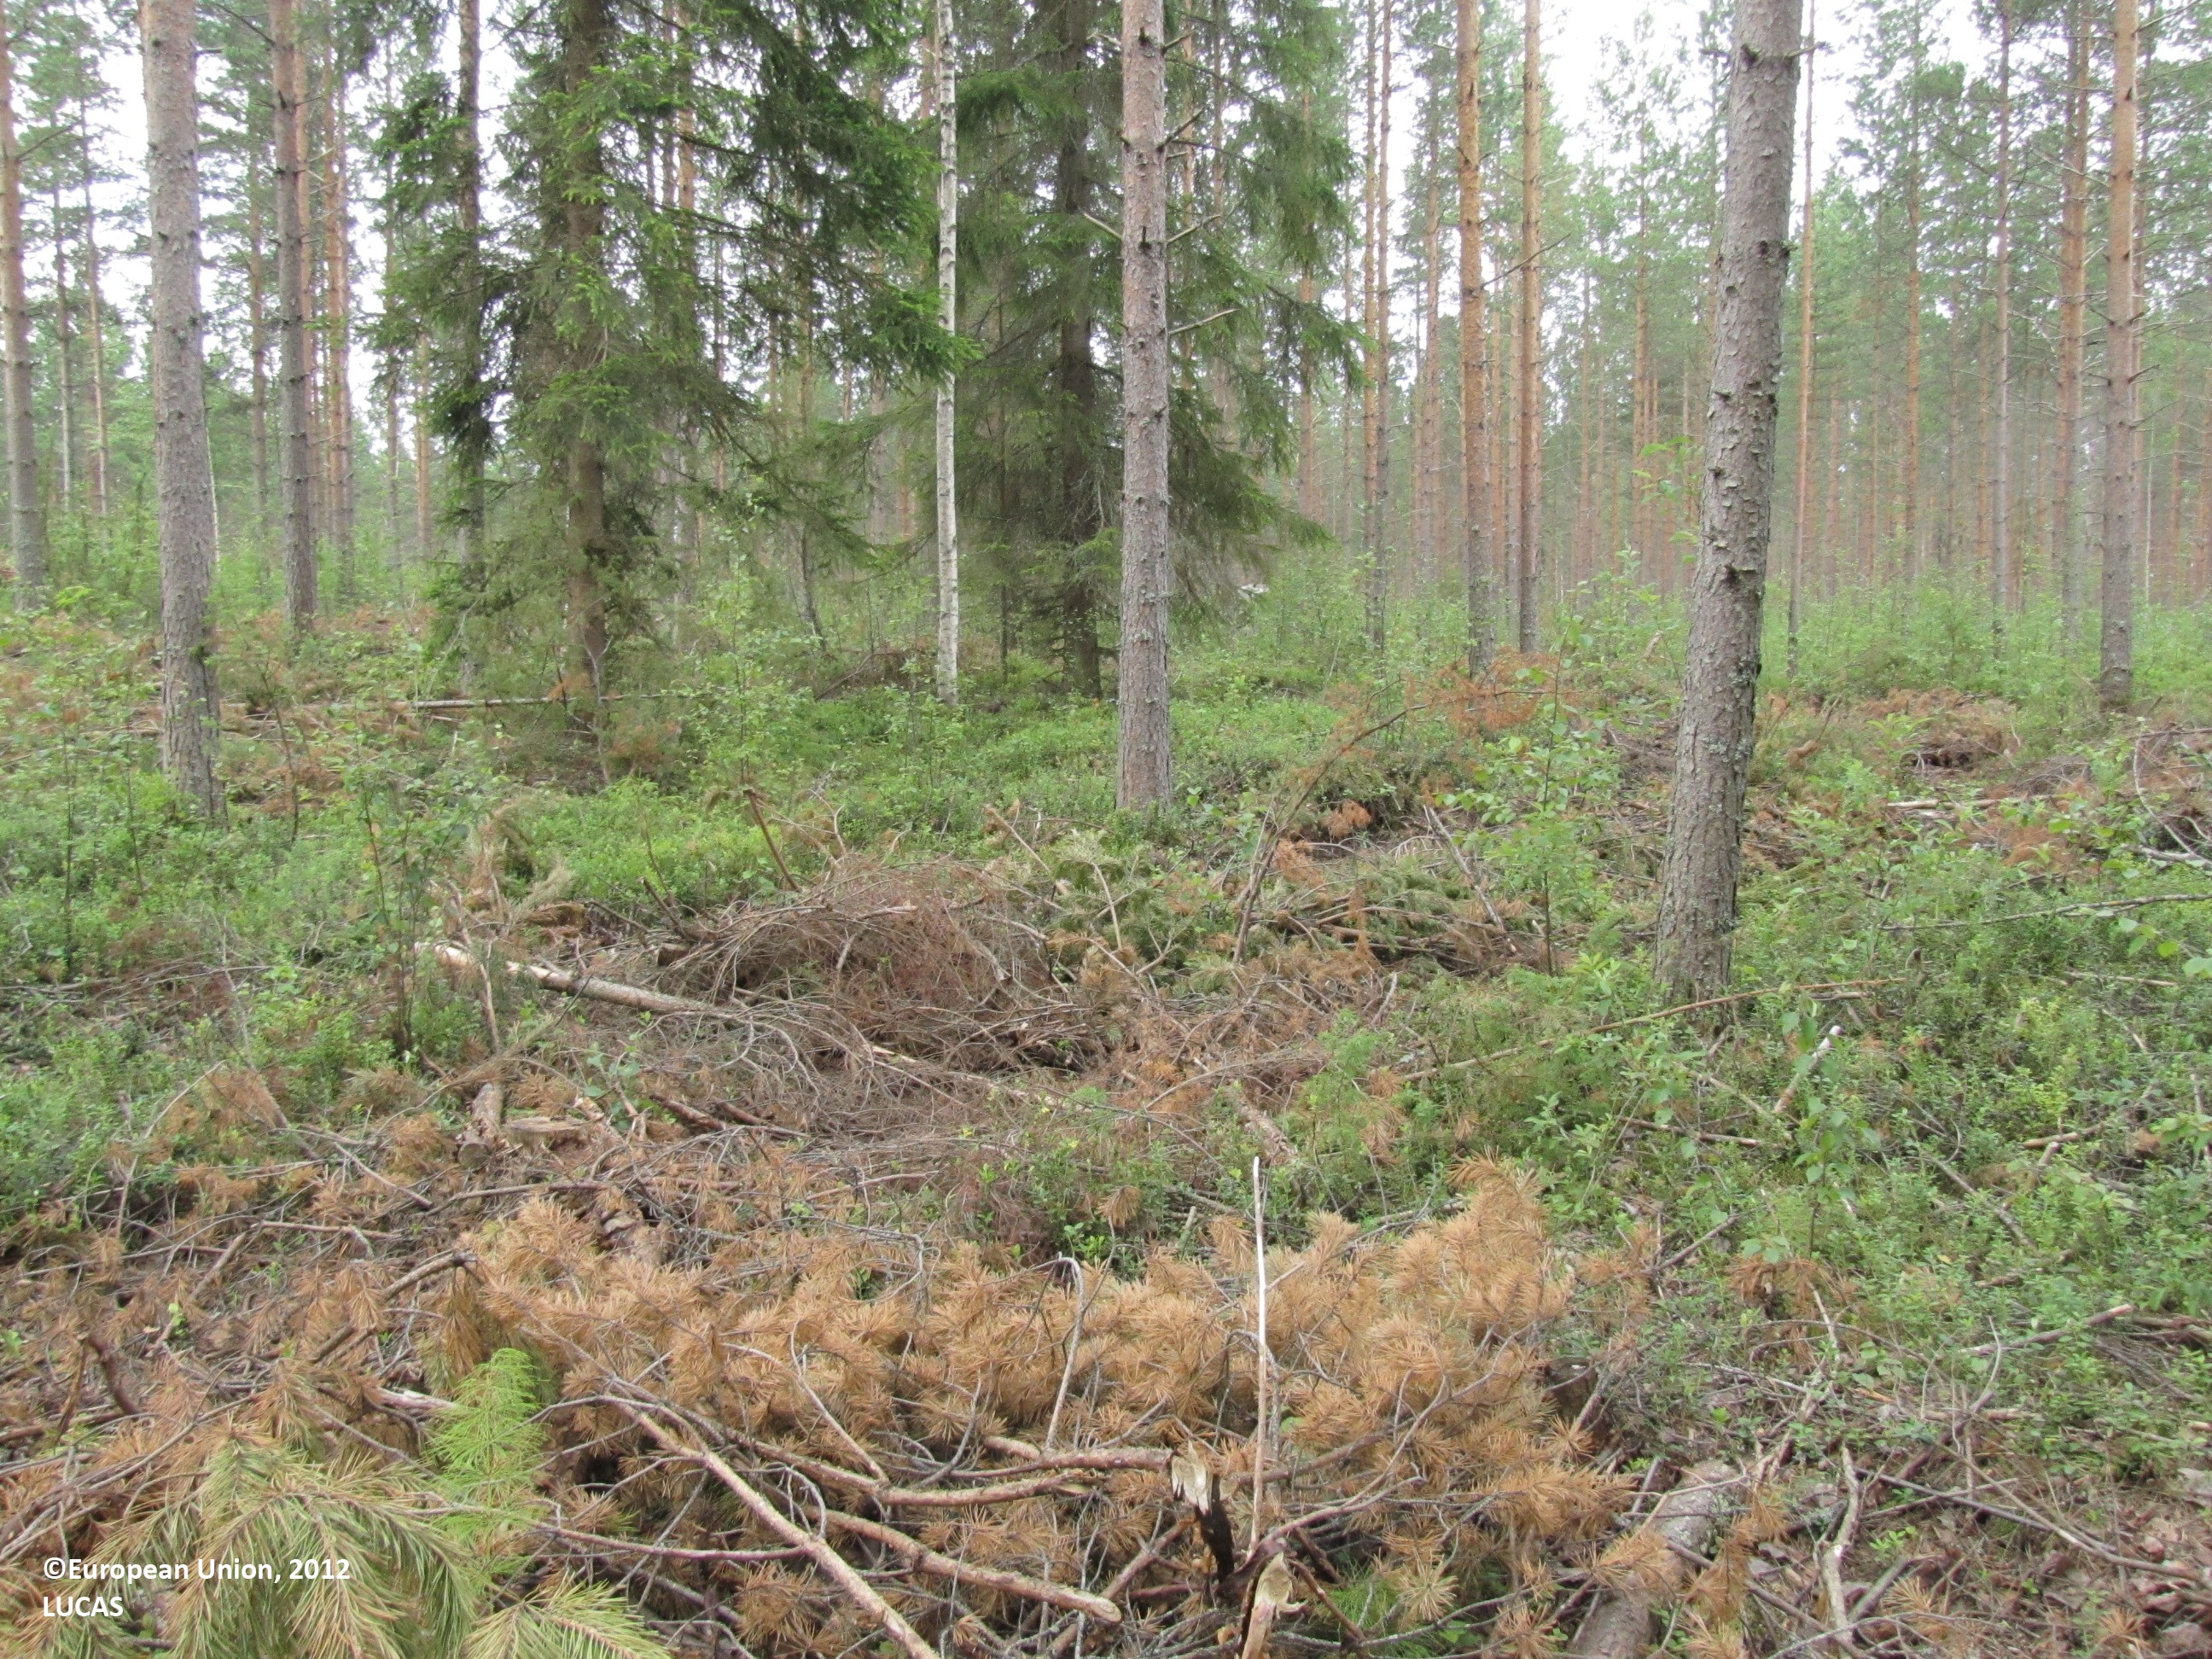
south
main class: Woodland
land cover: Pine dominated coniferous woodland
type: boreal forest
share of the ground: 50 - 75 %
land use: Forestry
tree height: > 5 m
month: July
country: FI
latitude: 62.6347
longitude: 23.3868
